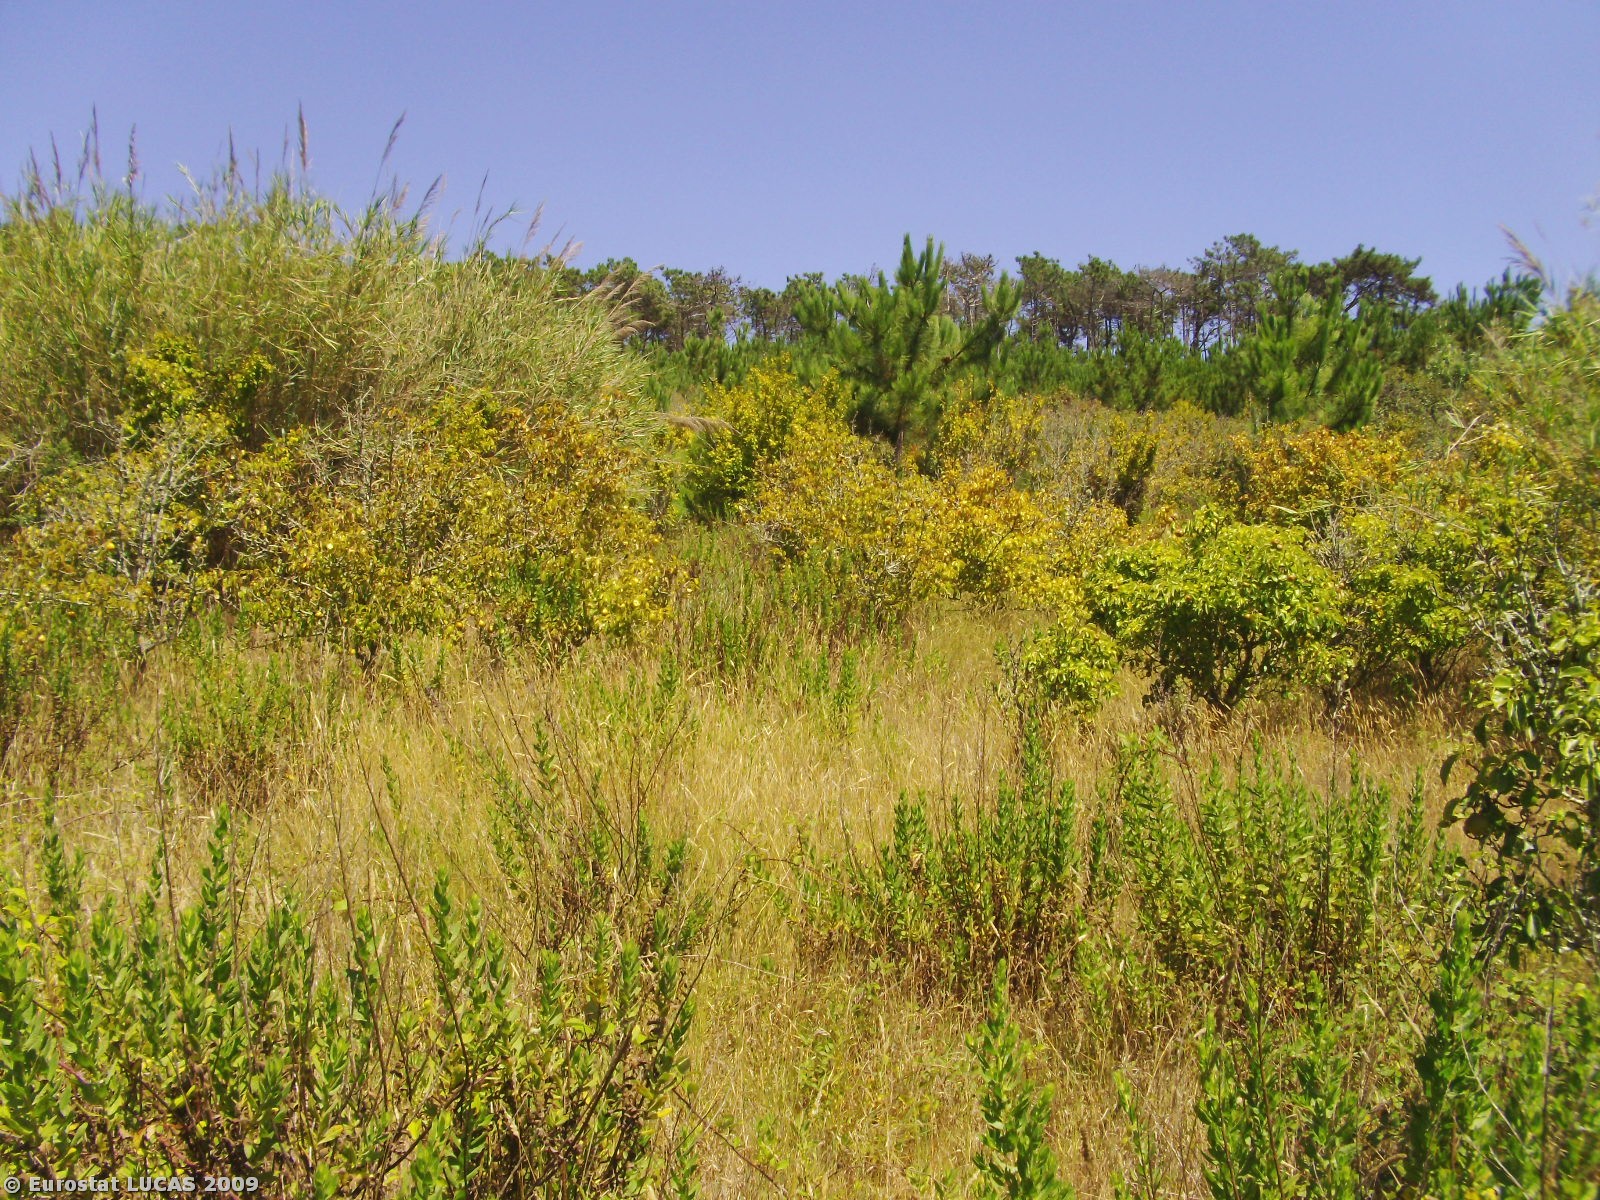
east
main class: Shrubland
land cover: Shrubland with sparse tree cover
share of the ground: > 75 %
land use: Unused
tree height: < 5 m
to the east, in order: Shrubland with sparse tree cover; Coniferous woodland; Shrubland without tree cover; Tracks; Coniferous woodland; Tracks; Shruby margins; Tracks; Coniferous woodland; Tracks; Coniferous woodland; Tracks; Fences; Artificial constructions in urban areas
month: July
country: PT
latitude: 39.2540
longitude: -9.3162
